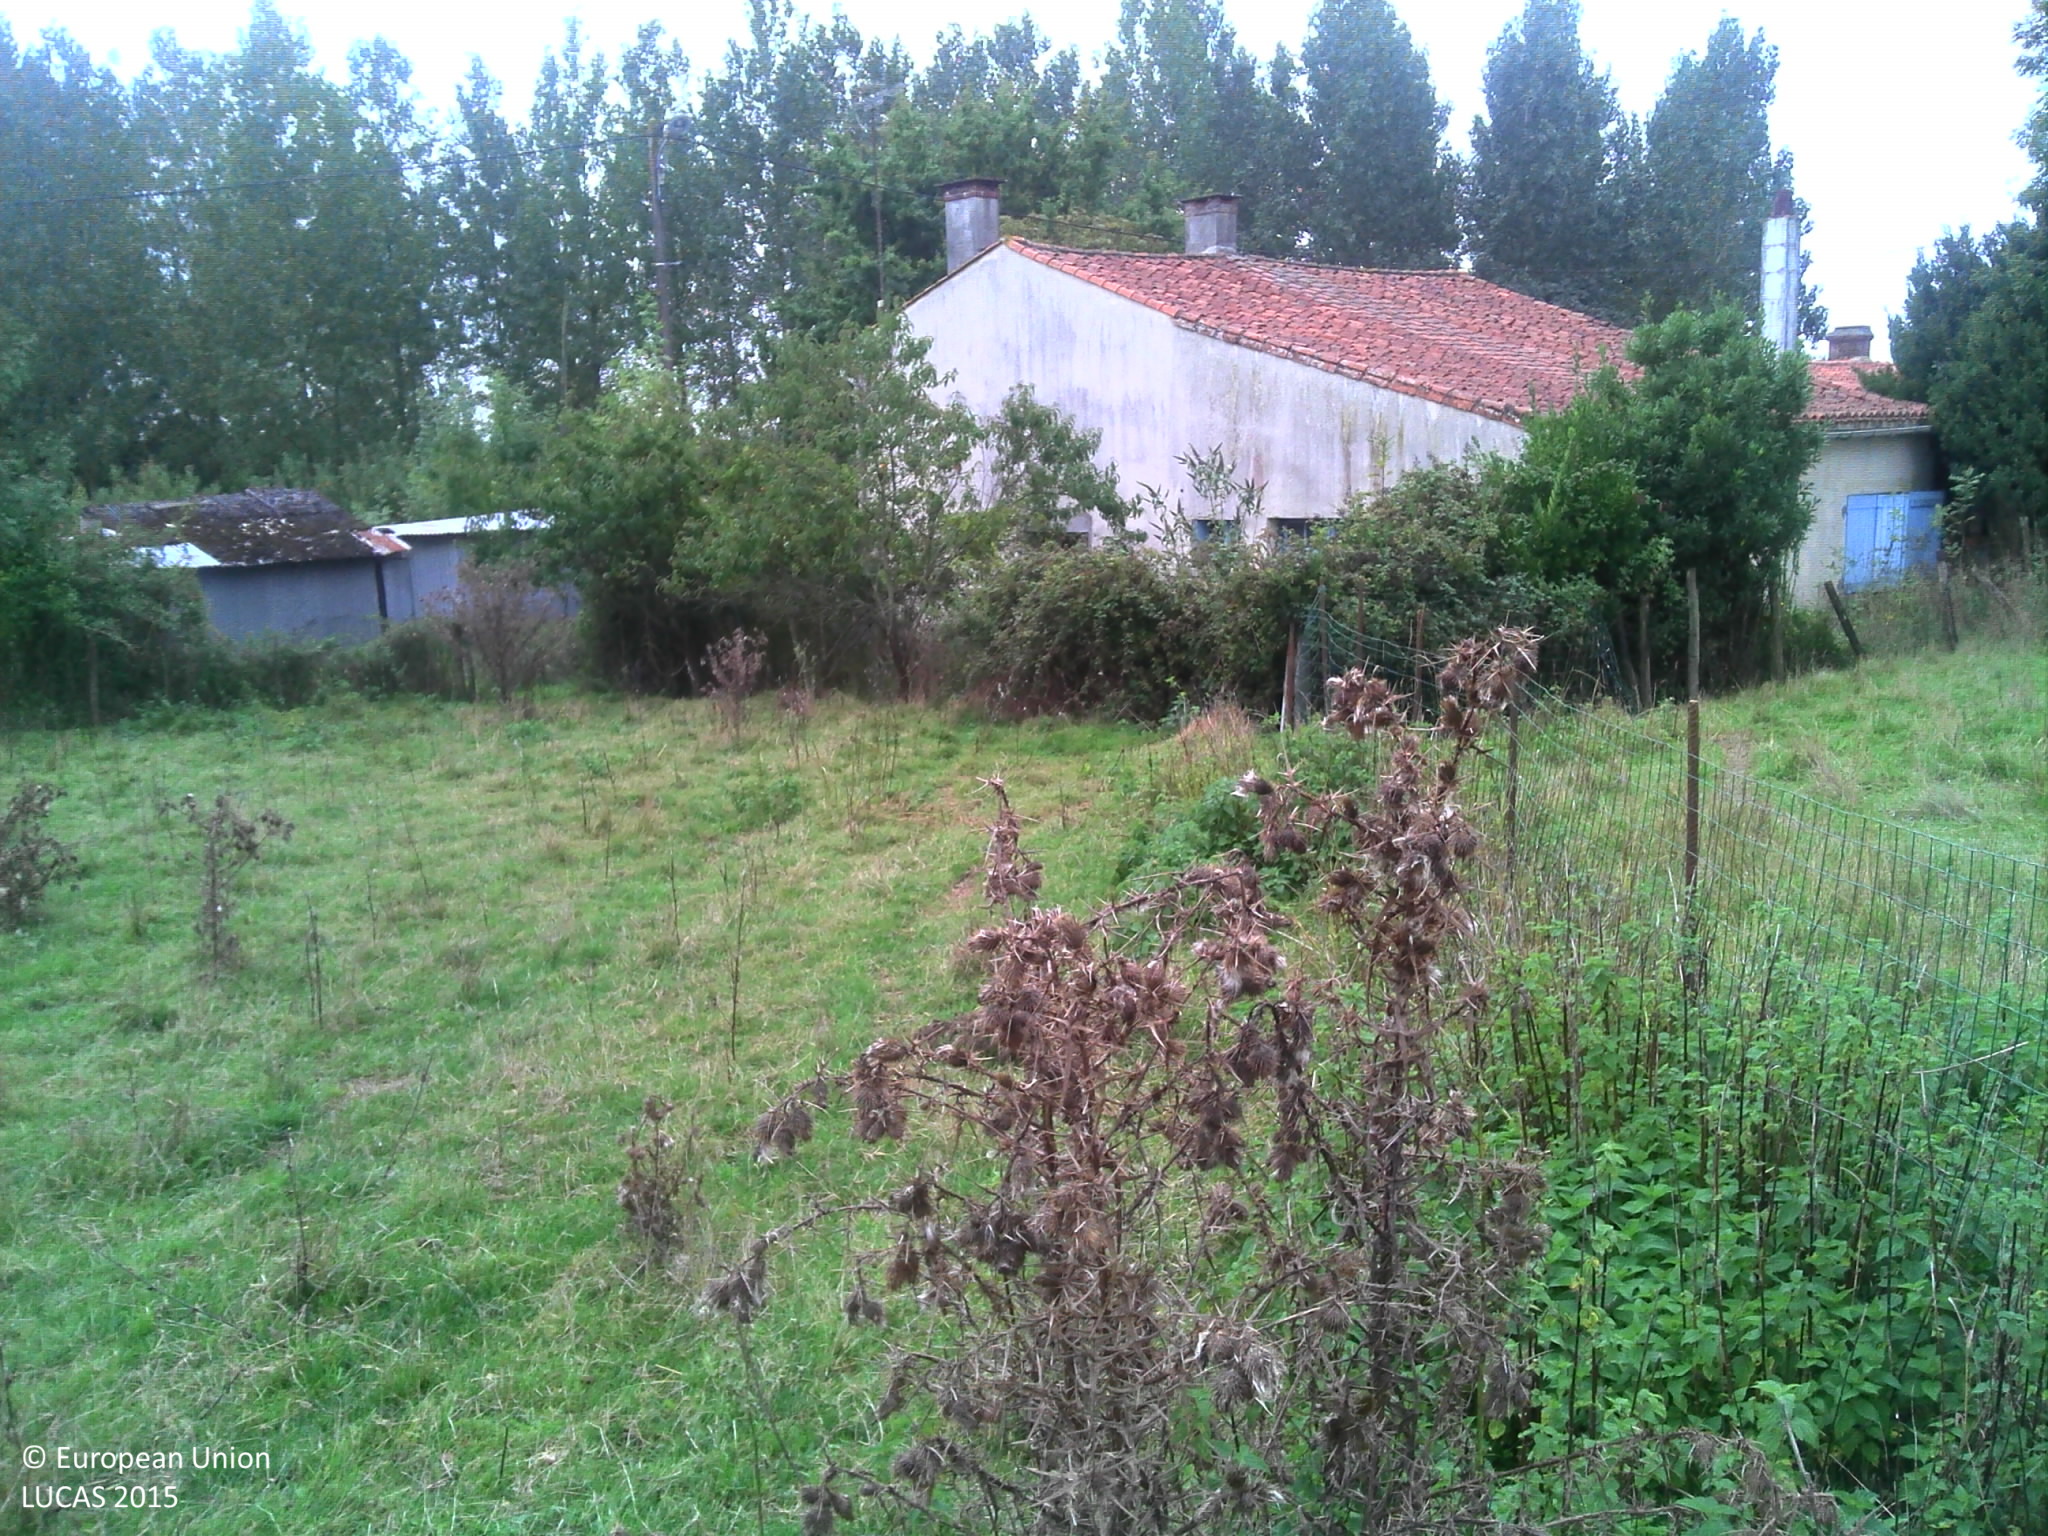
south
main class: Grassland
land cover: Grassland without tree/shrub cover
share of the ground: > 75 %
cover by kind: herbaceous plants 100 %
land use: Agriculture (excluding fallow land and kitchen gardens)
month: September
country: FR
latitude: 46.6492
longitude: -1.0478
